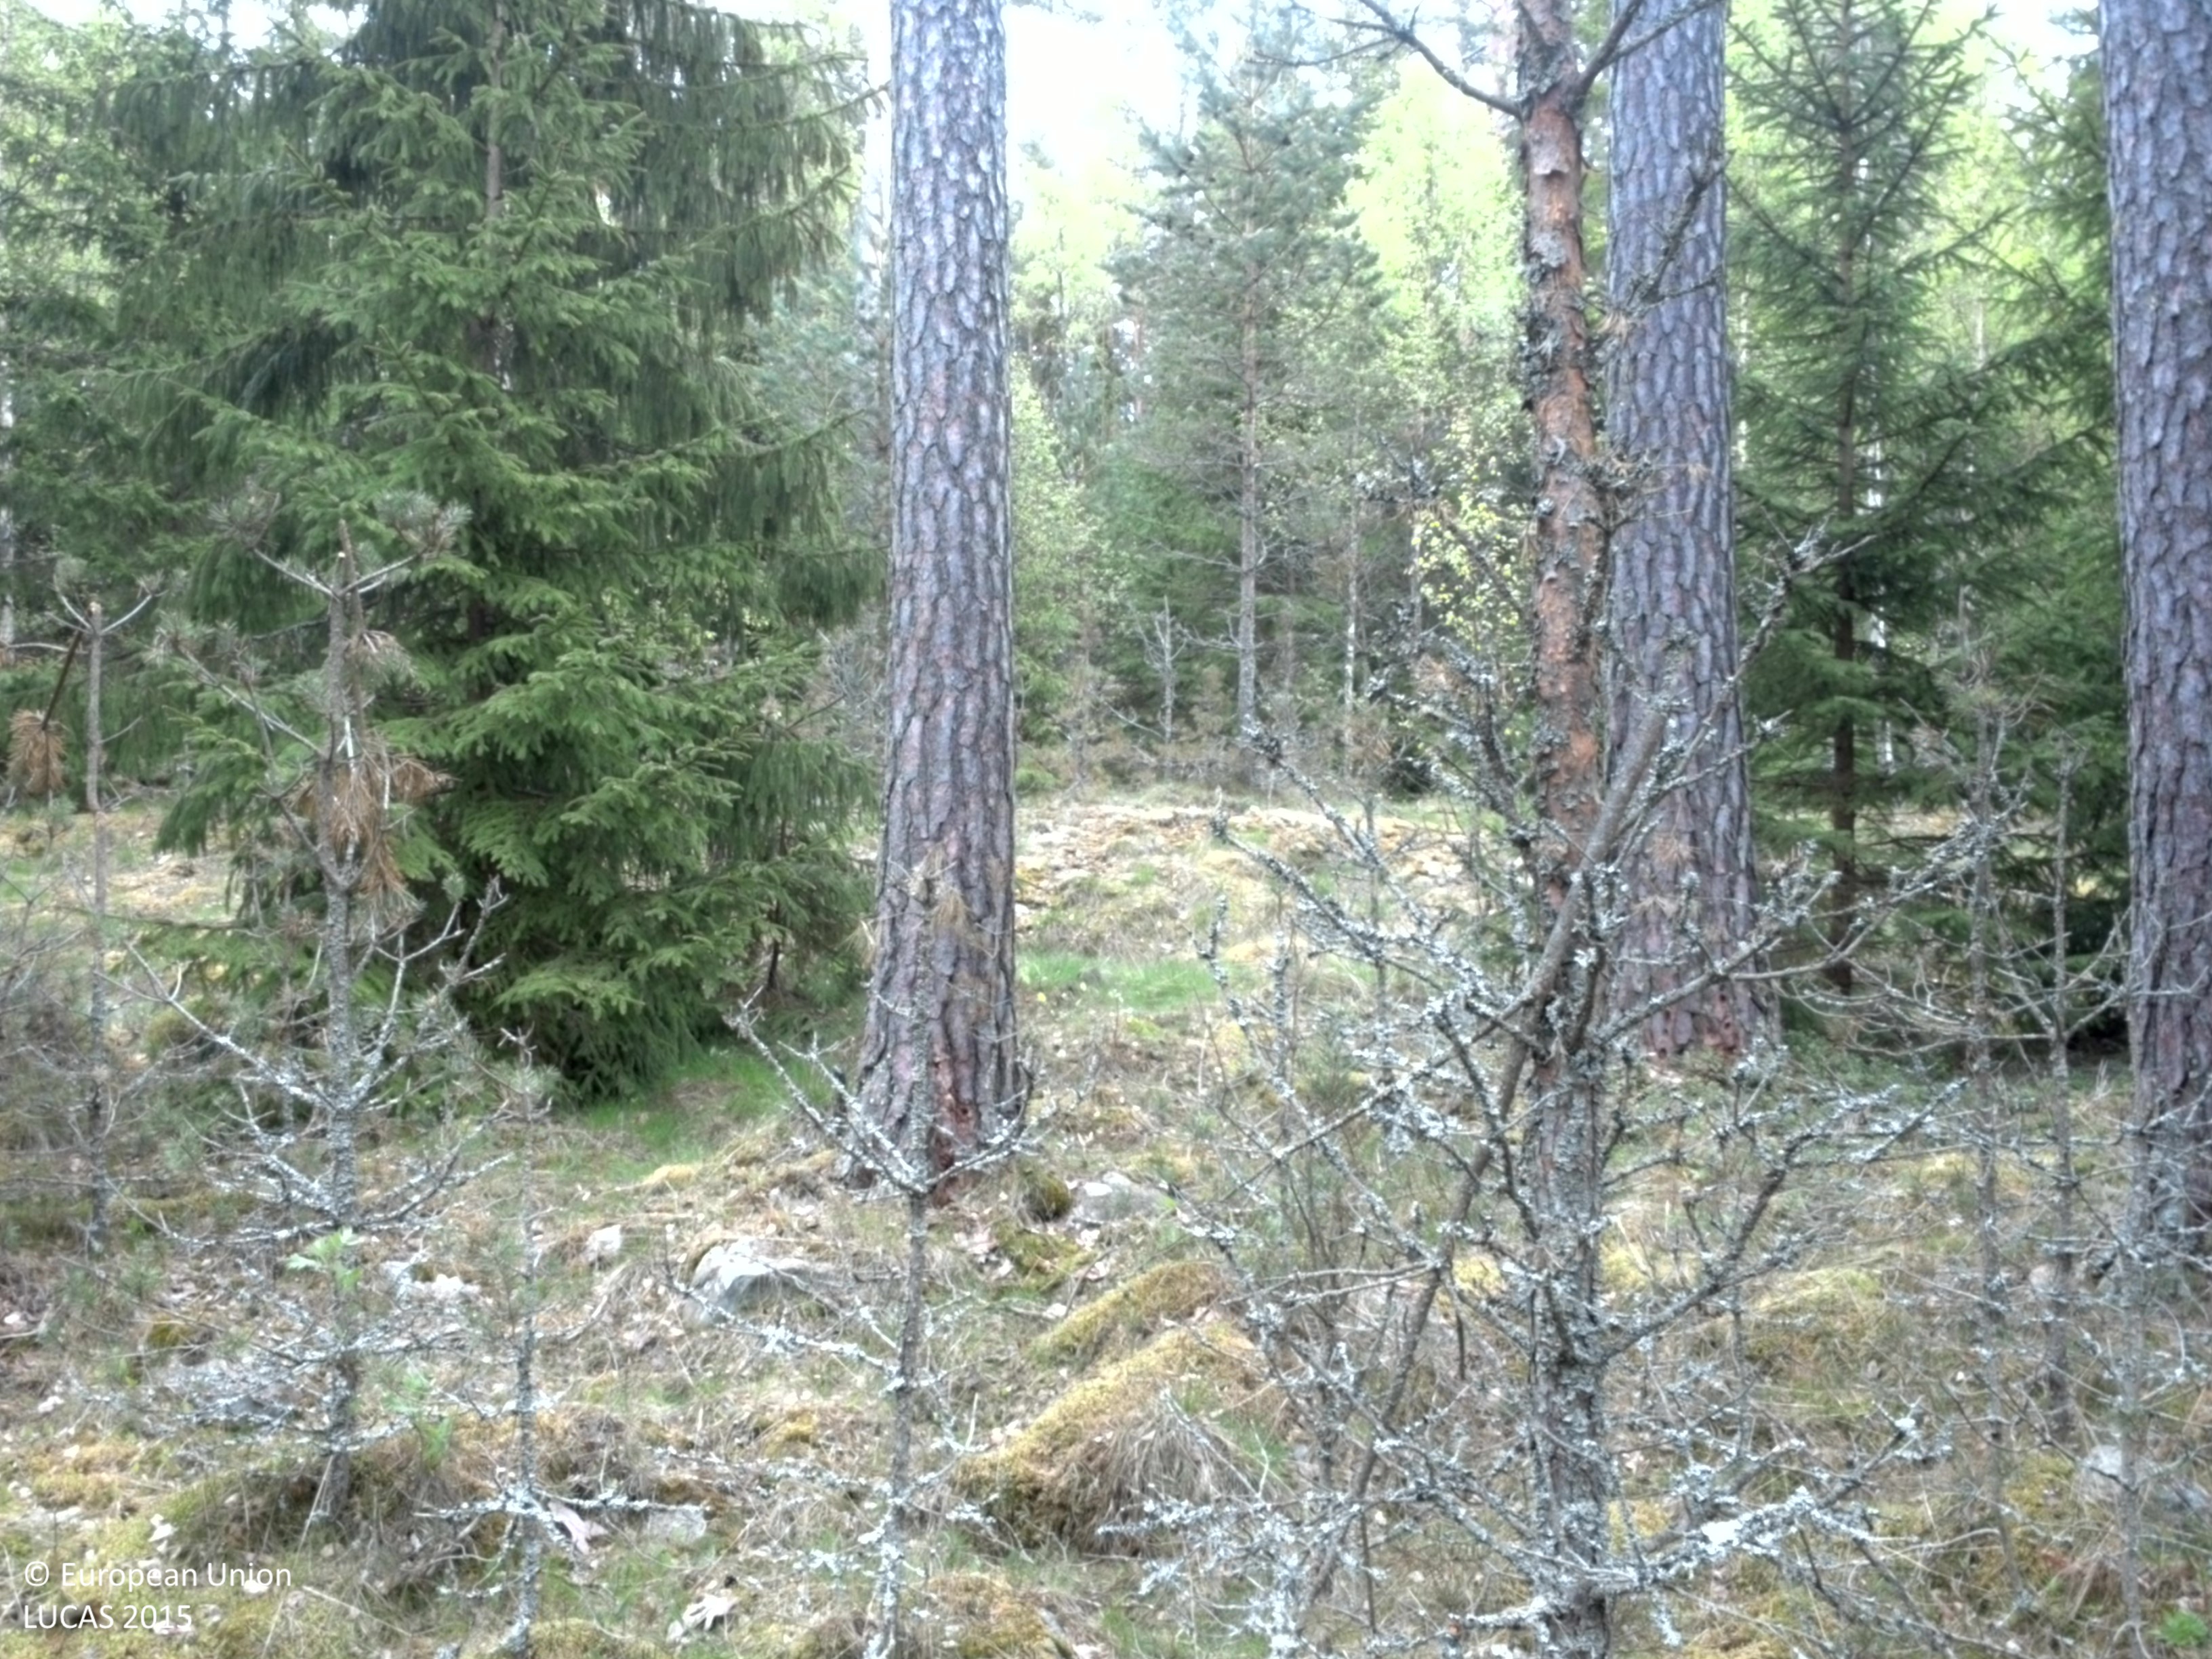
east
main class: Woodland
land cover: Pine dominated mixed woodland
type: boreal forest
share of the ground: > 75 %
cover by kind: coniferous forest trees 60 %, broadleaved forest trees 20 %, shrubs 10 %, herbaceous plants 10 %
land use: Forestry
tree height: > 5 m
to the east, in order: Pine dominated mixed woodland; Spruce dominated mixed woodland; Pine dominated coniferous woodland; Other coniferous woodland; Spruce dominated mixed woodland
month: May
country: SE
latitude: 59.2566
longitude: 14.0782
